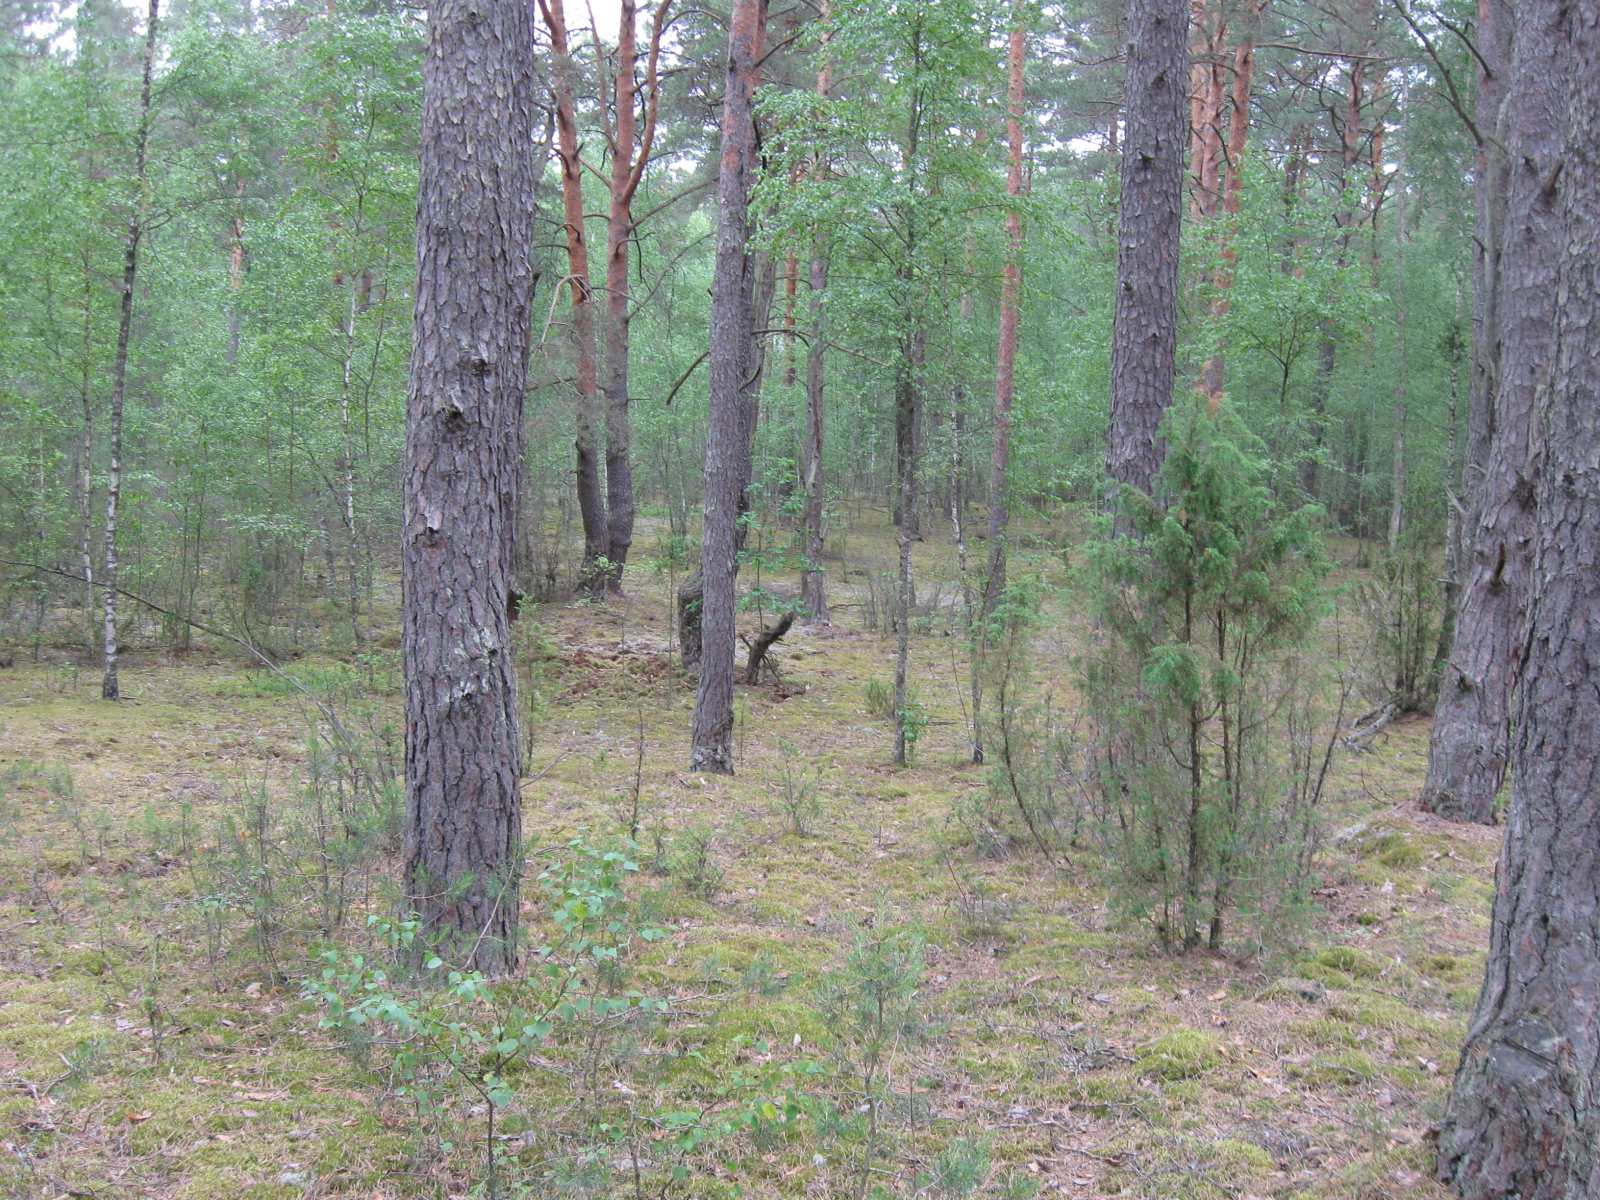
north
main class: Woodland
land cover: Pine dominated coniferous woodland
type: hemiboreal forest and nemoral coniferous forest and mixed broadleaved-coniferous forest
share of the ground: > 75 %
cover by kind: coniferous forest trees 80 %, broadleaved forest trees 15 %, lichens and mosses 5 %
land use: Forestry
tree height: > 5 m
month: July
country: LT
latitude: 54.1212
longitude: 24.2822
